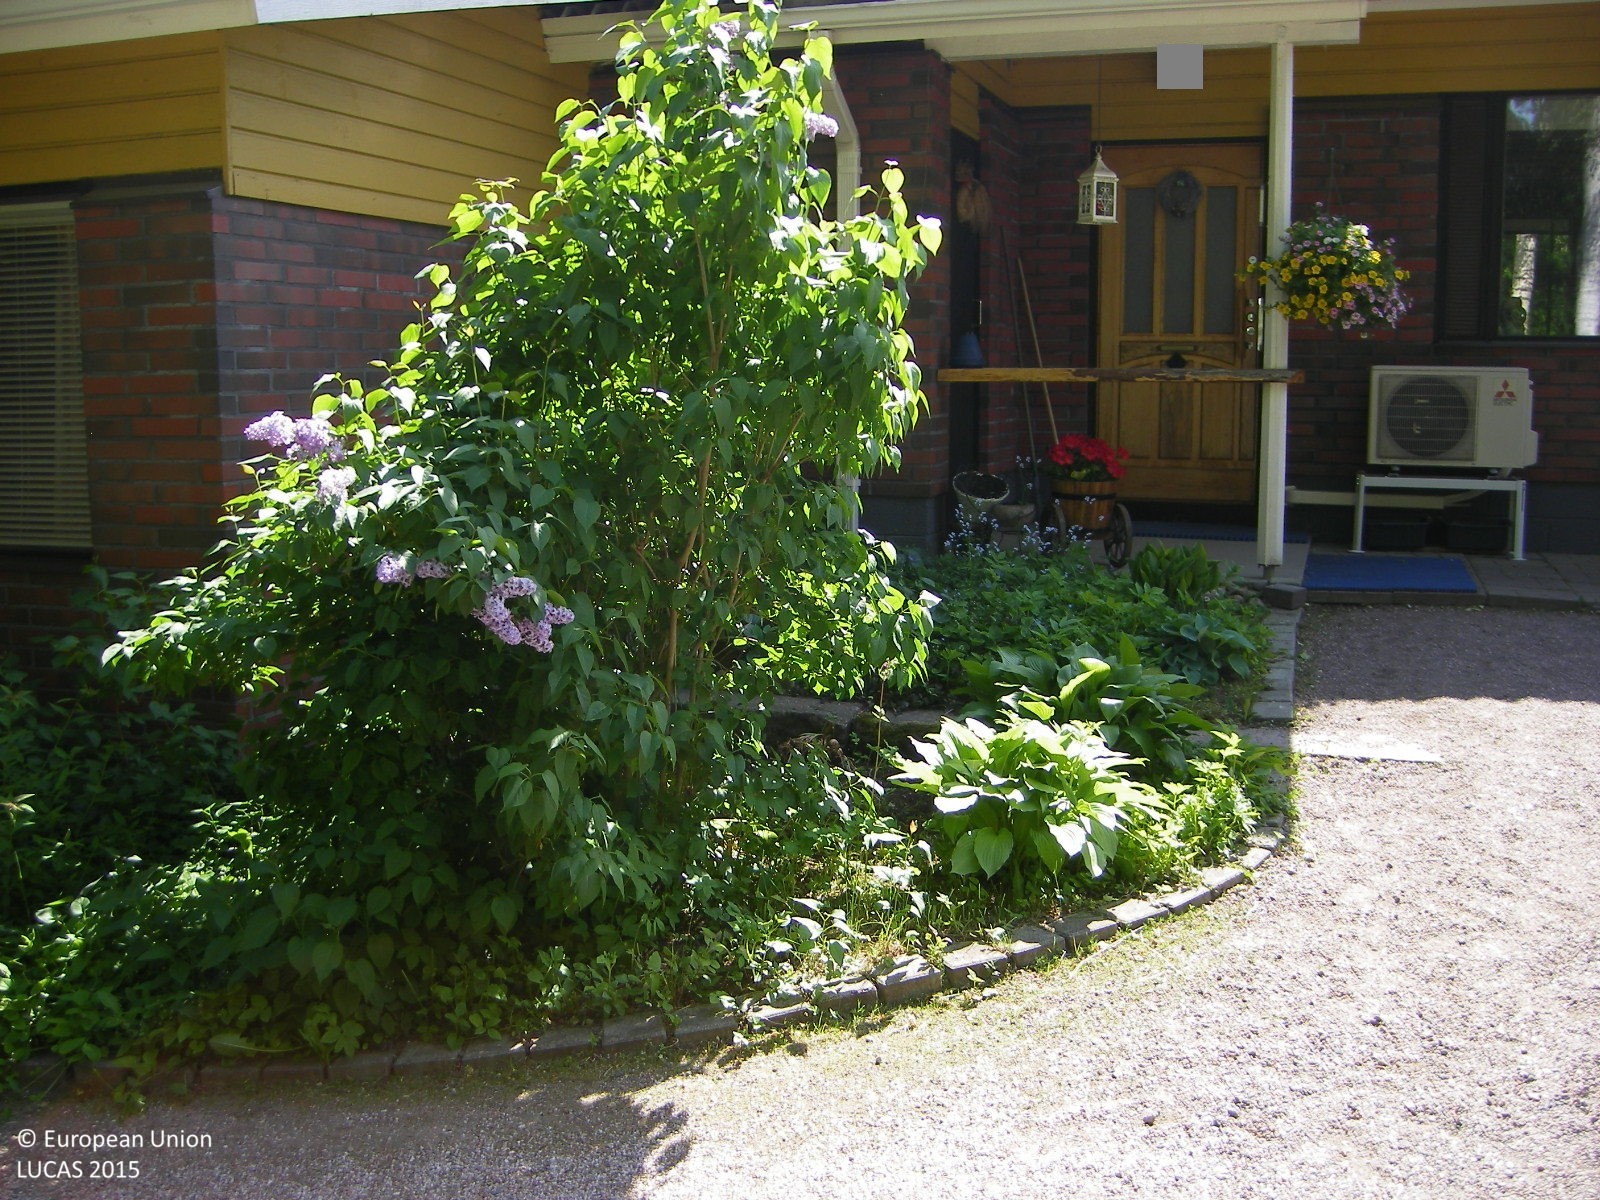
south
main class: Grassland
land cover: Grassland with sparse tree/shrub cover
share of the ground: > 75 %
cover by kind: herbaceous plants 85 %, broadleaved forest trees 5 %, shrubs 5 %, unconsolidated bare surface 5 %
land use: Residential
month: June
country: FI
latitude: 60.3707
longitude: 24.4126
